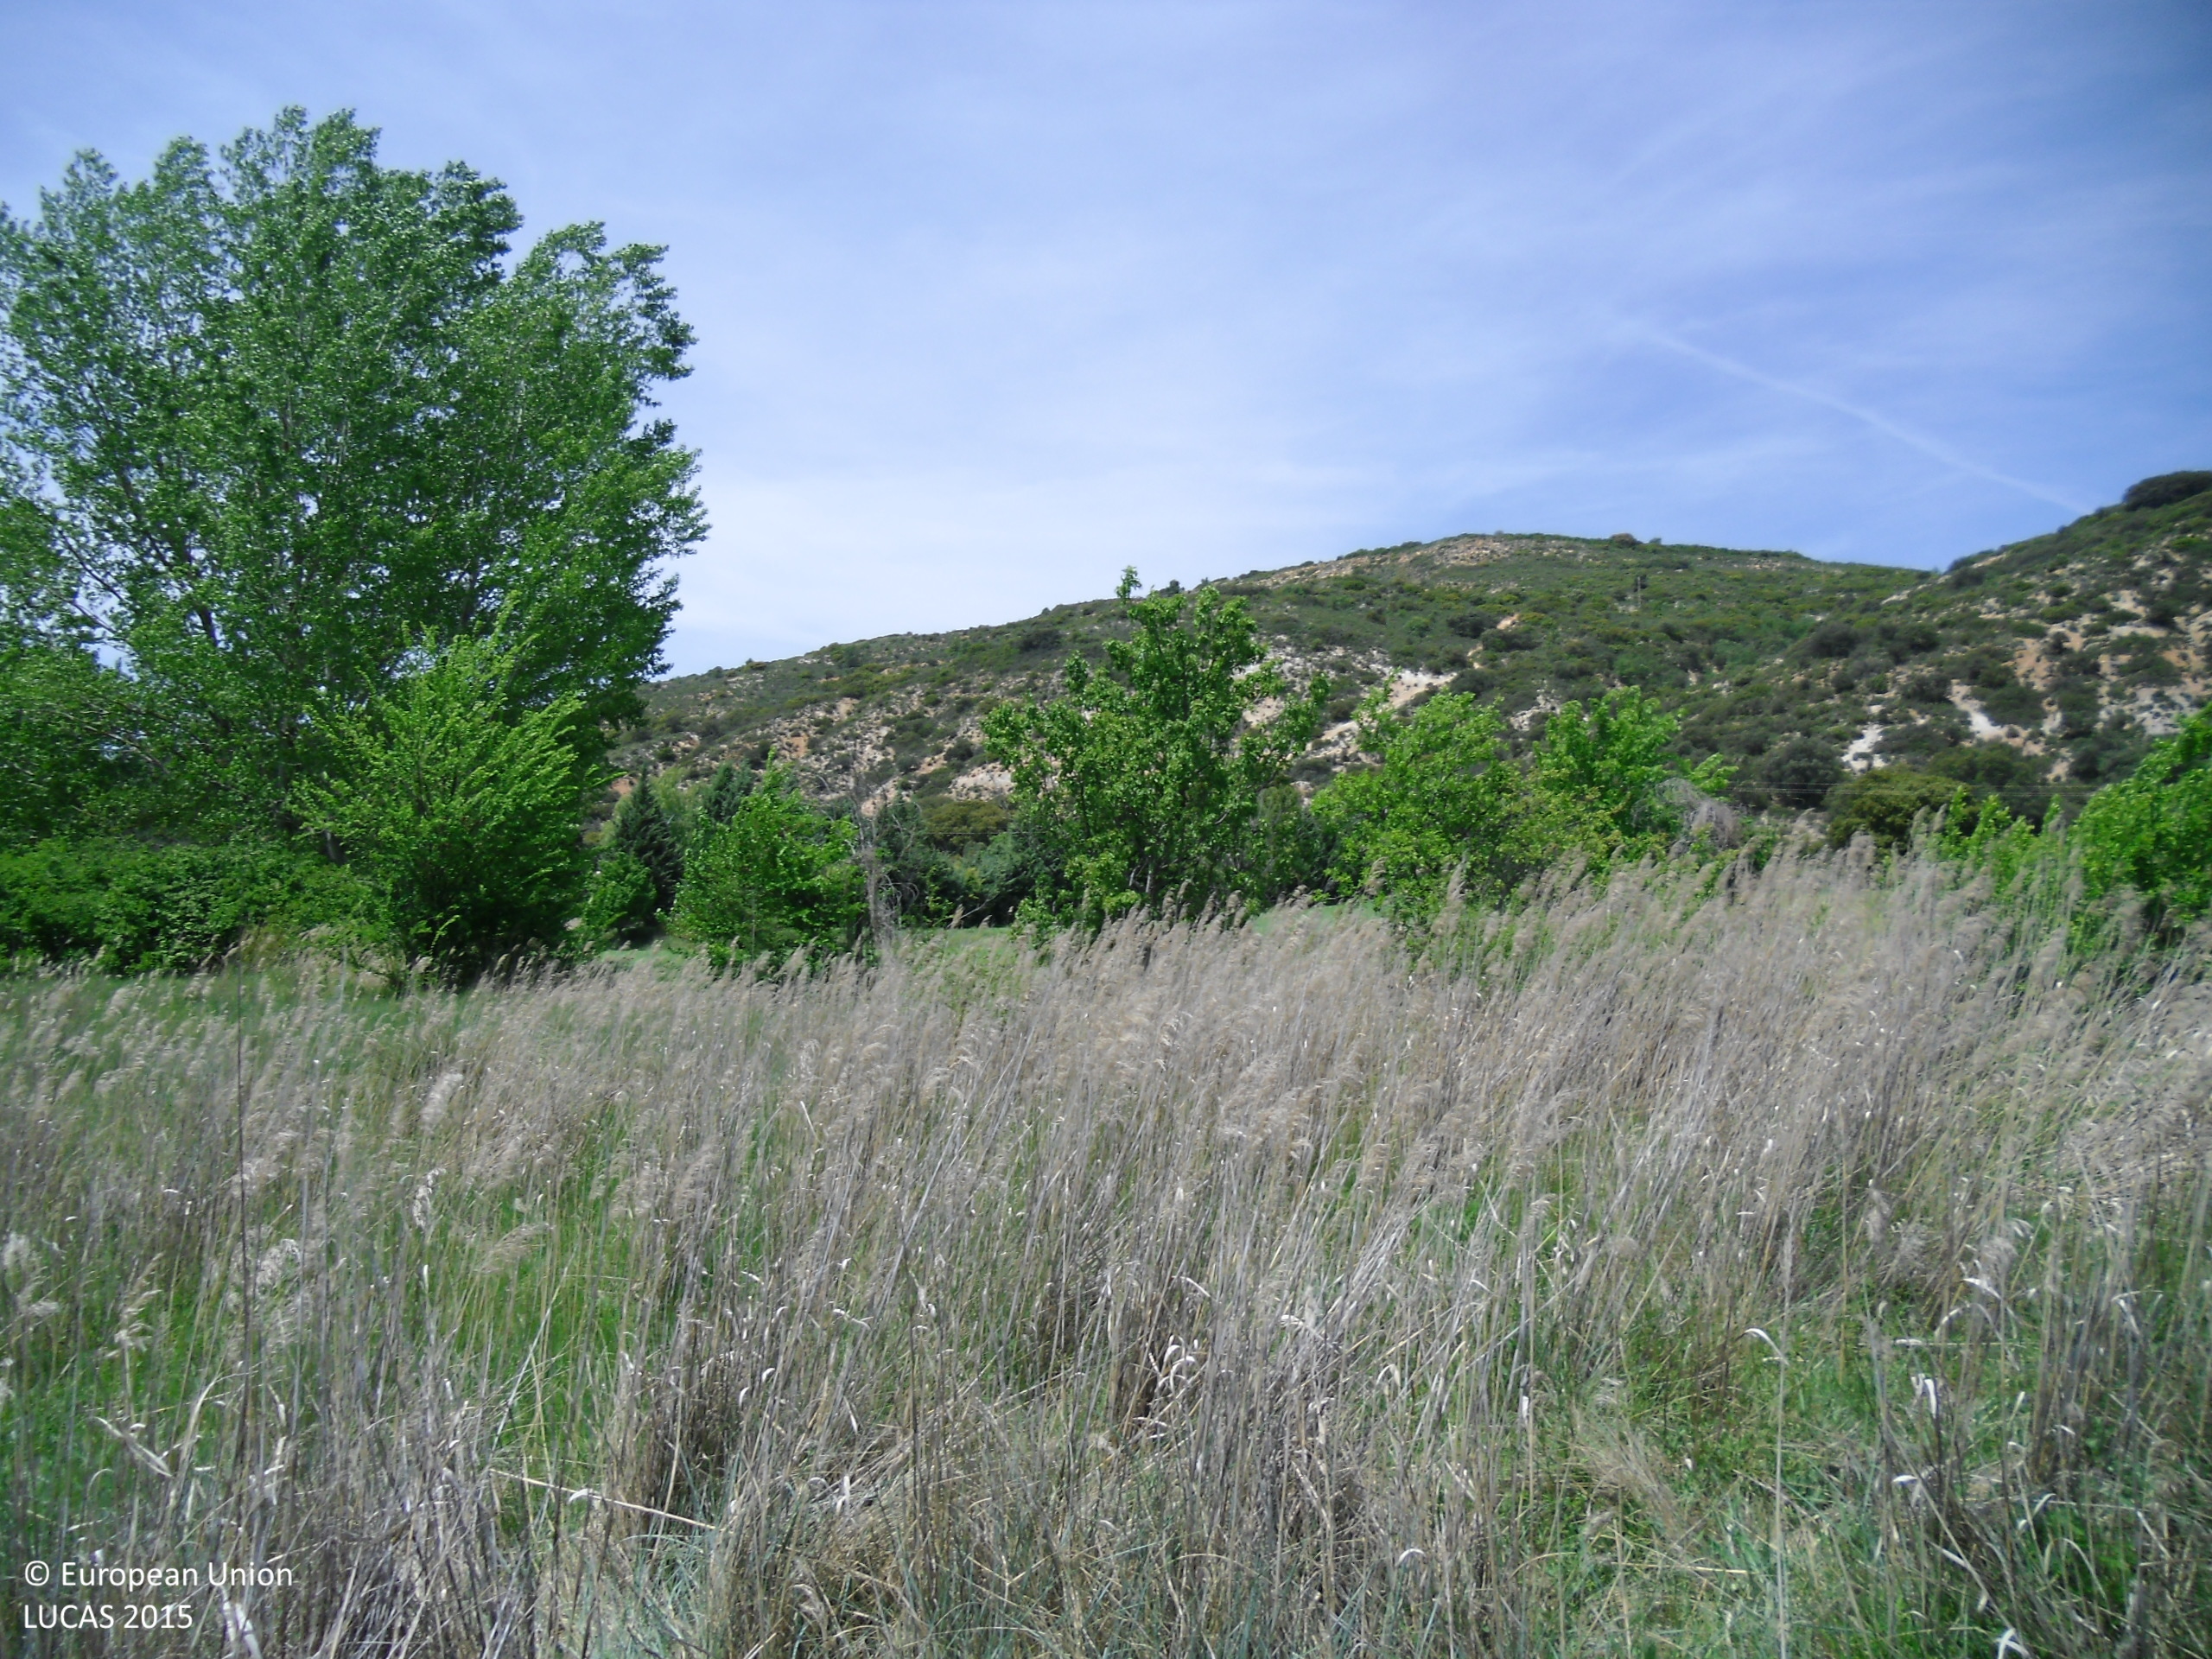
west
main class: Grassland
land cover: Grassland without tree/shrub cover
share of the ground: > 75 %
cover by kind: herbaceous plants 100 %
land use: Semi-natural and natural areas not in use
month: May
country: ES
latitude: 40.4965
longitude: -2.9970
